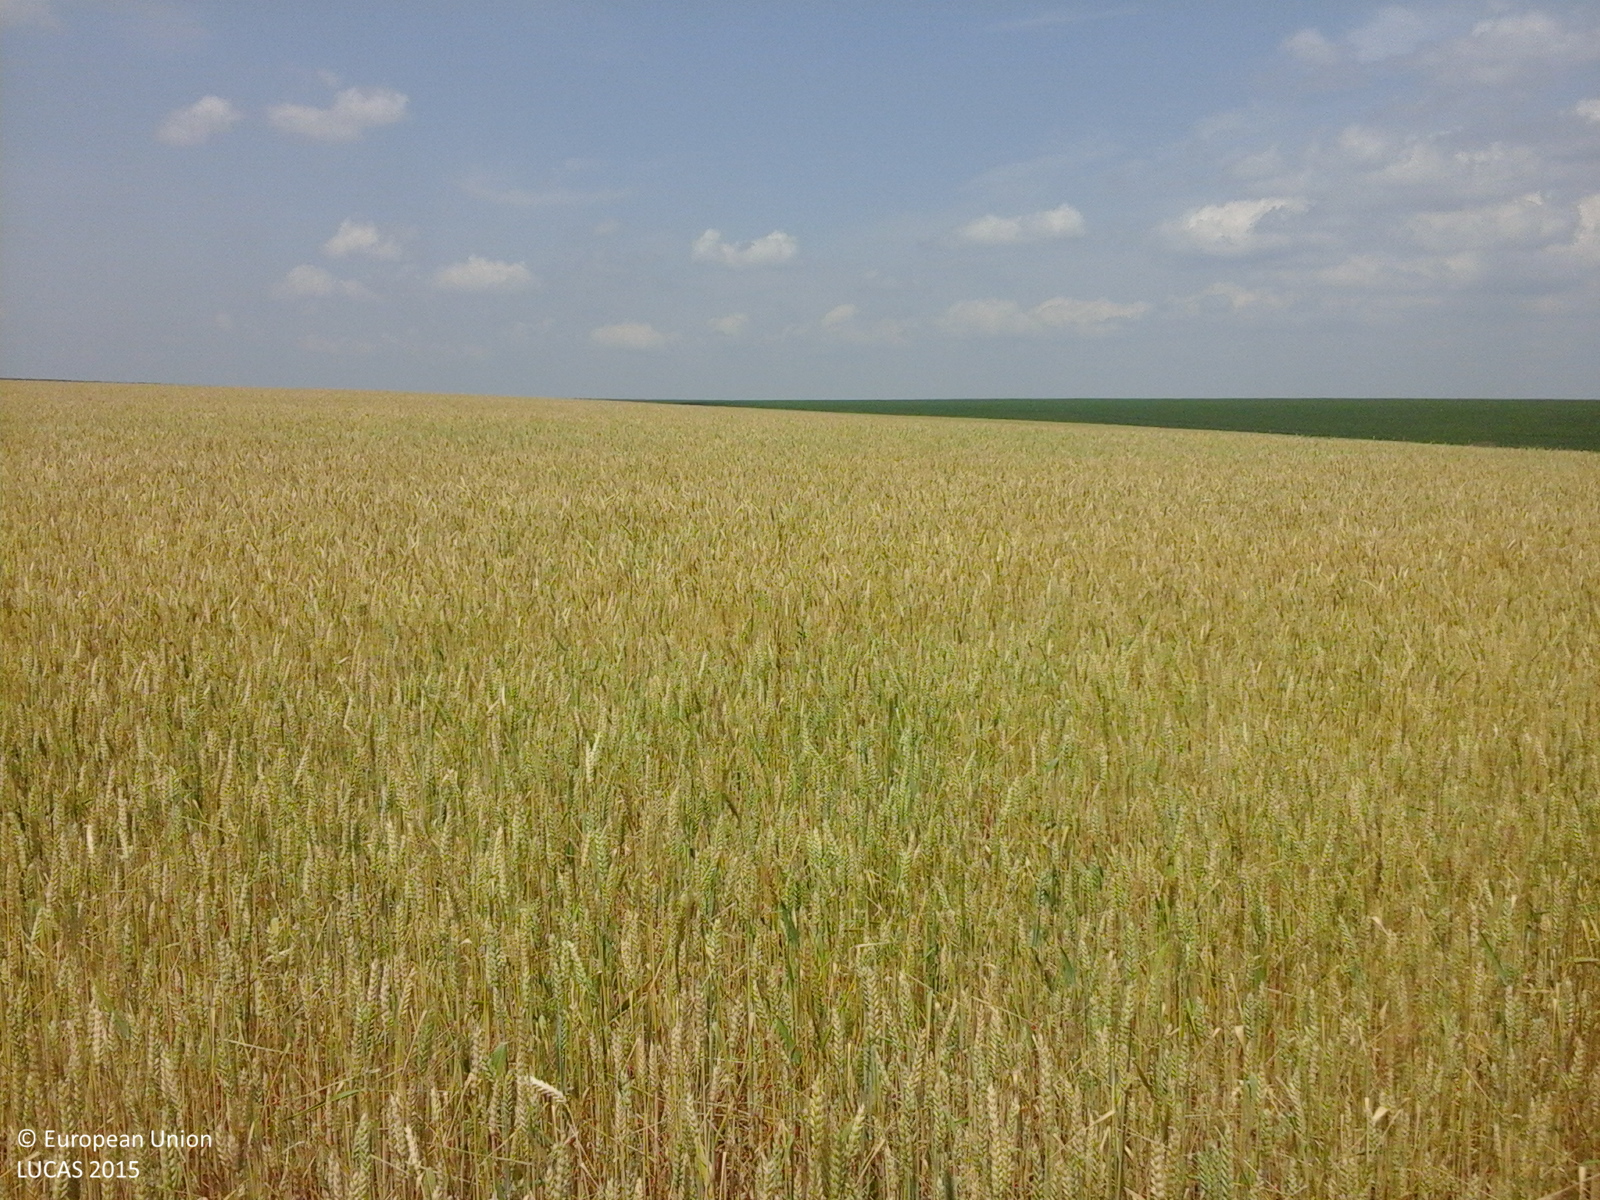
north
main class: Cropland
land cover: Common wheat
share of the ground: > 75 %
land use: Agriculture (excluding fallow land and kitchen gardens)
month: June
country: RO
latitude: 47.4443
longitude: 26.9838
